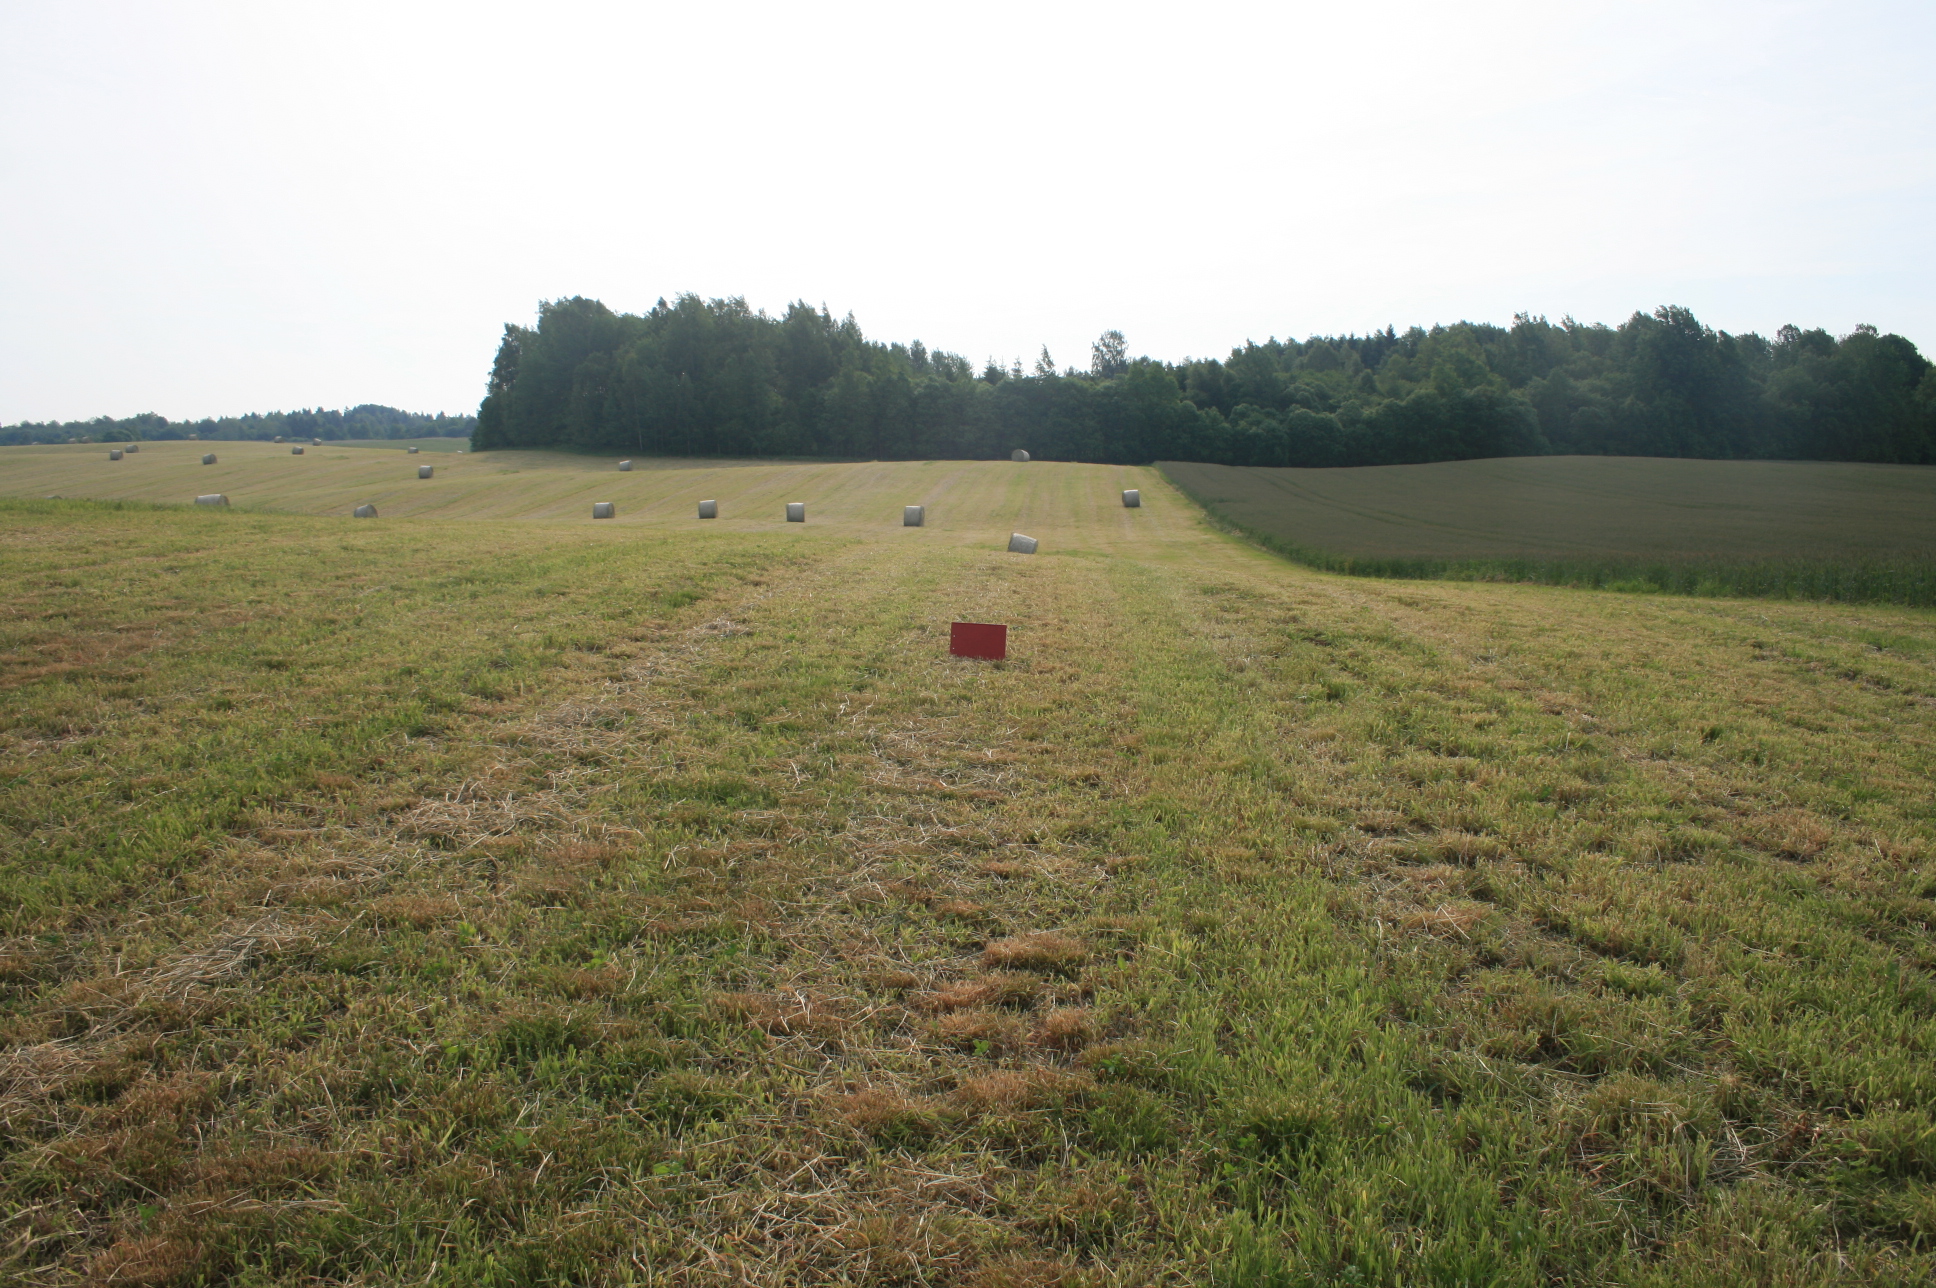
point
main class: Grassland
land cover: Grassland without tree/shrub cover
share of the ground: > 75 %
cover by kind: herbaceous plants 100 %
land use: Agriculture (excluding fallow land and kitchen gardens)
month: June
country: LT
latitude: 55.7269
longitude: 22.2367
